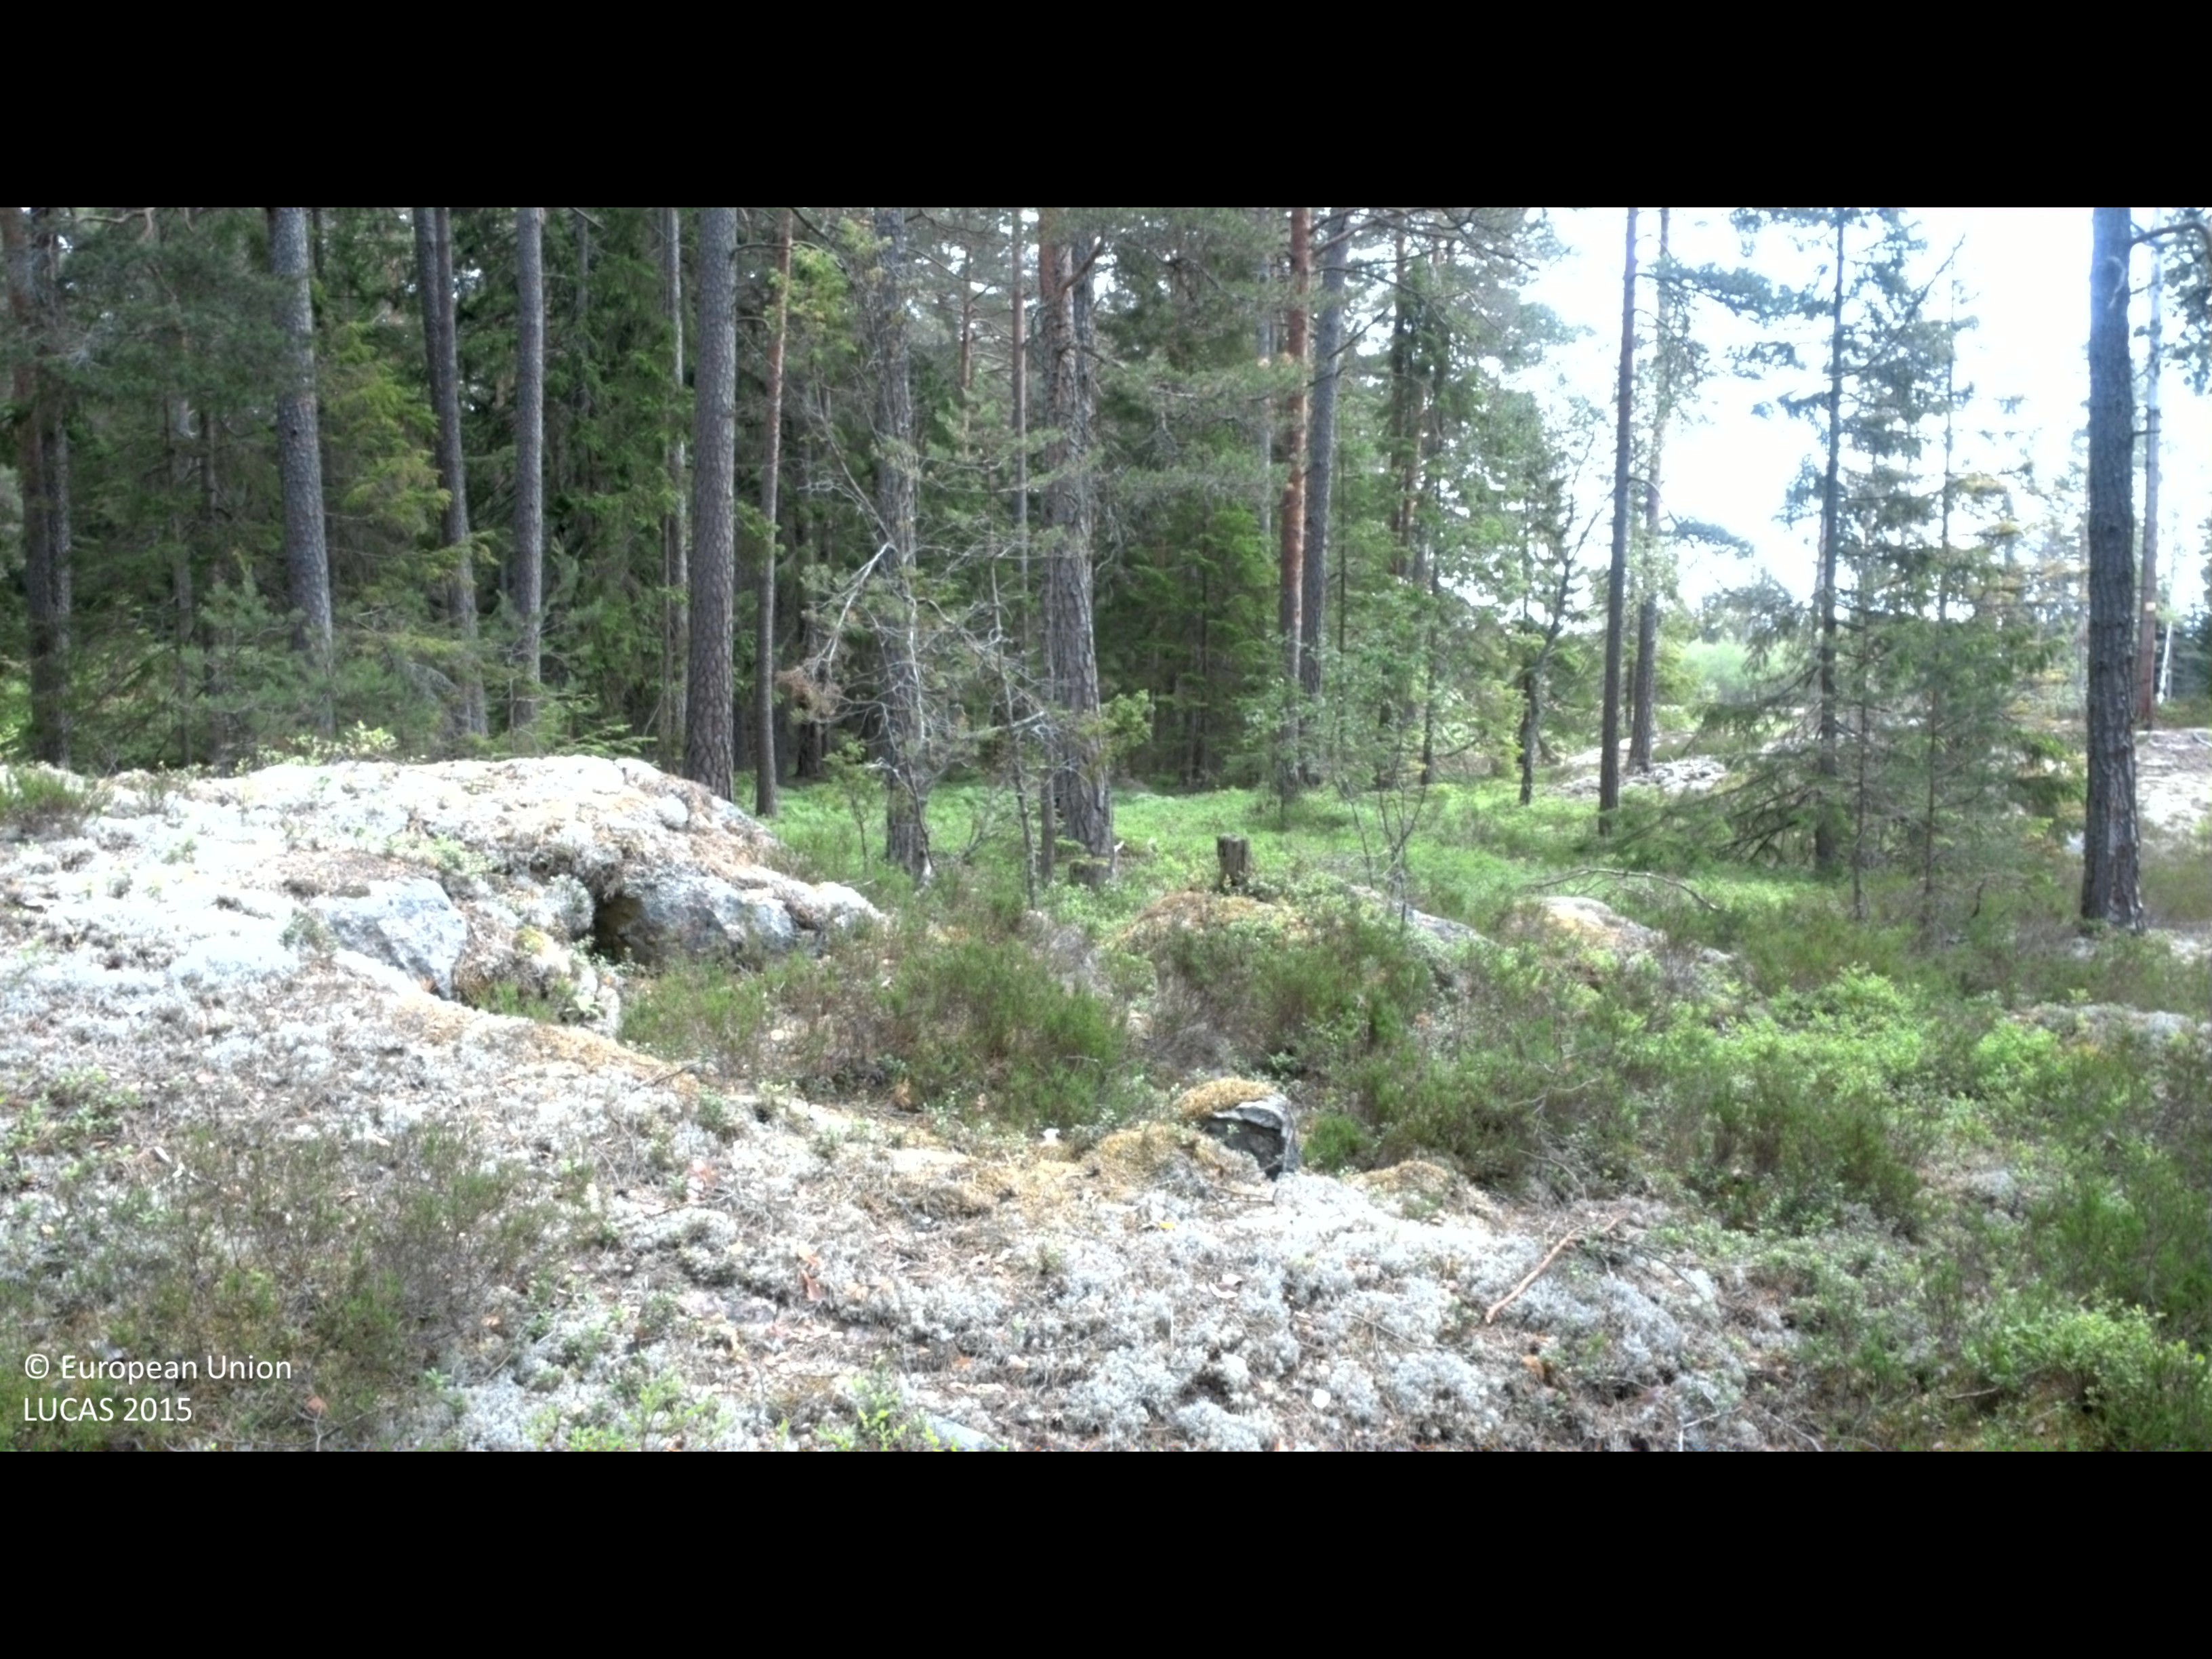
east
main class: Woodland
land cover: Pine dominated coniferous woodland
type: boreal forest
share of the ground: 50 - 75 %
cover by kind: coniferous forest trees 70 %, shrubs 20 %, broadleaved forest trees 5 %, lichens and mosses 5 %
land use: Forestry
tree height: > 5 m
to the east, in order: Pine dominated coniferous woodland; Spruce dominated mixed woodland; Spruce dominated coniferous woodland; Pine dominated coniferous woodland
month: June
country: SE
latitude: 57.9293
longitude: 16.6345
